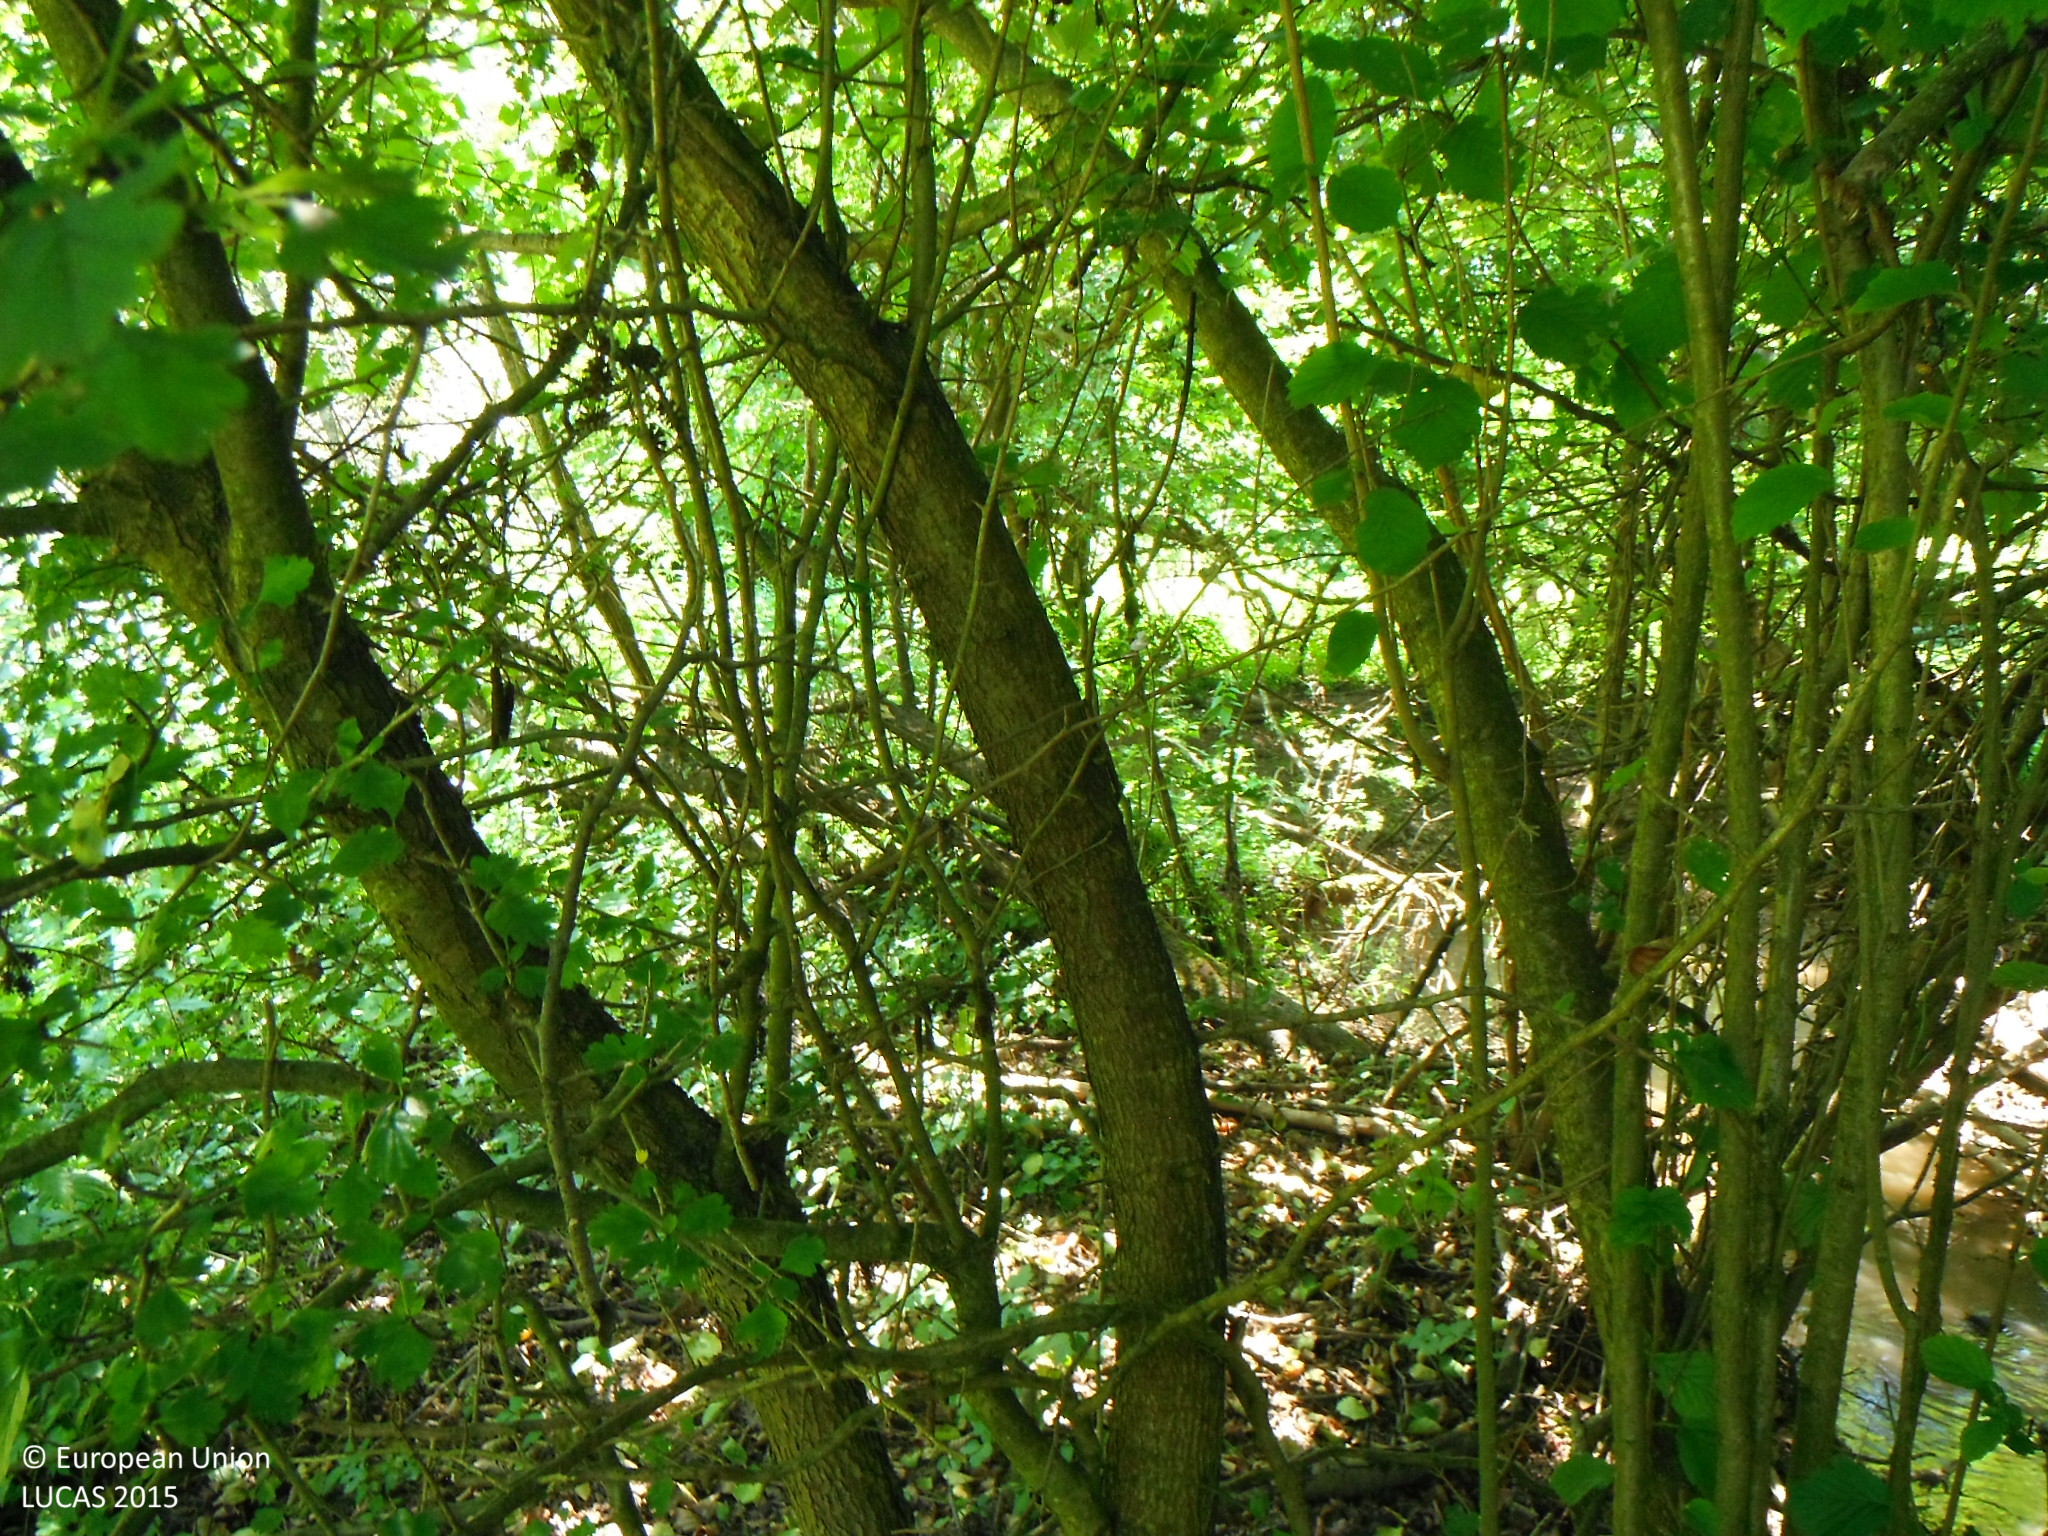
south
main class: Woodland
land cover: Broadleaved woodland
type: floodplain forest
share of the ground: > 75 %
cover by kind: broadleaved forest trees 100 %
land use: Forestry
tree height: > 5 m
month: July
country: SK
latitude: 48.2373
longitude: 19.1906
